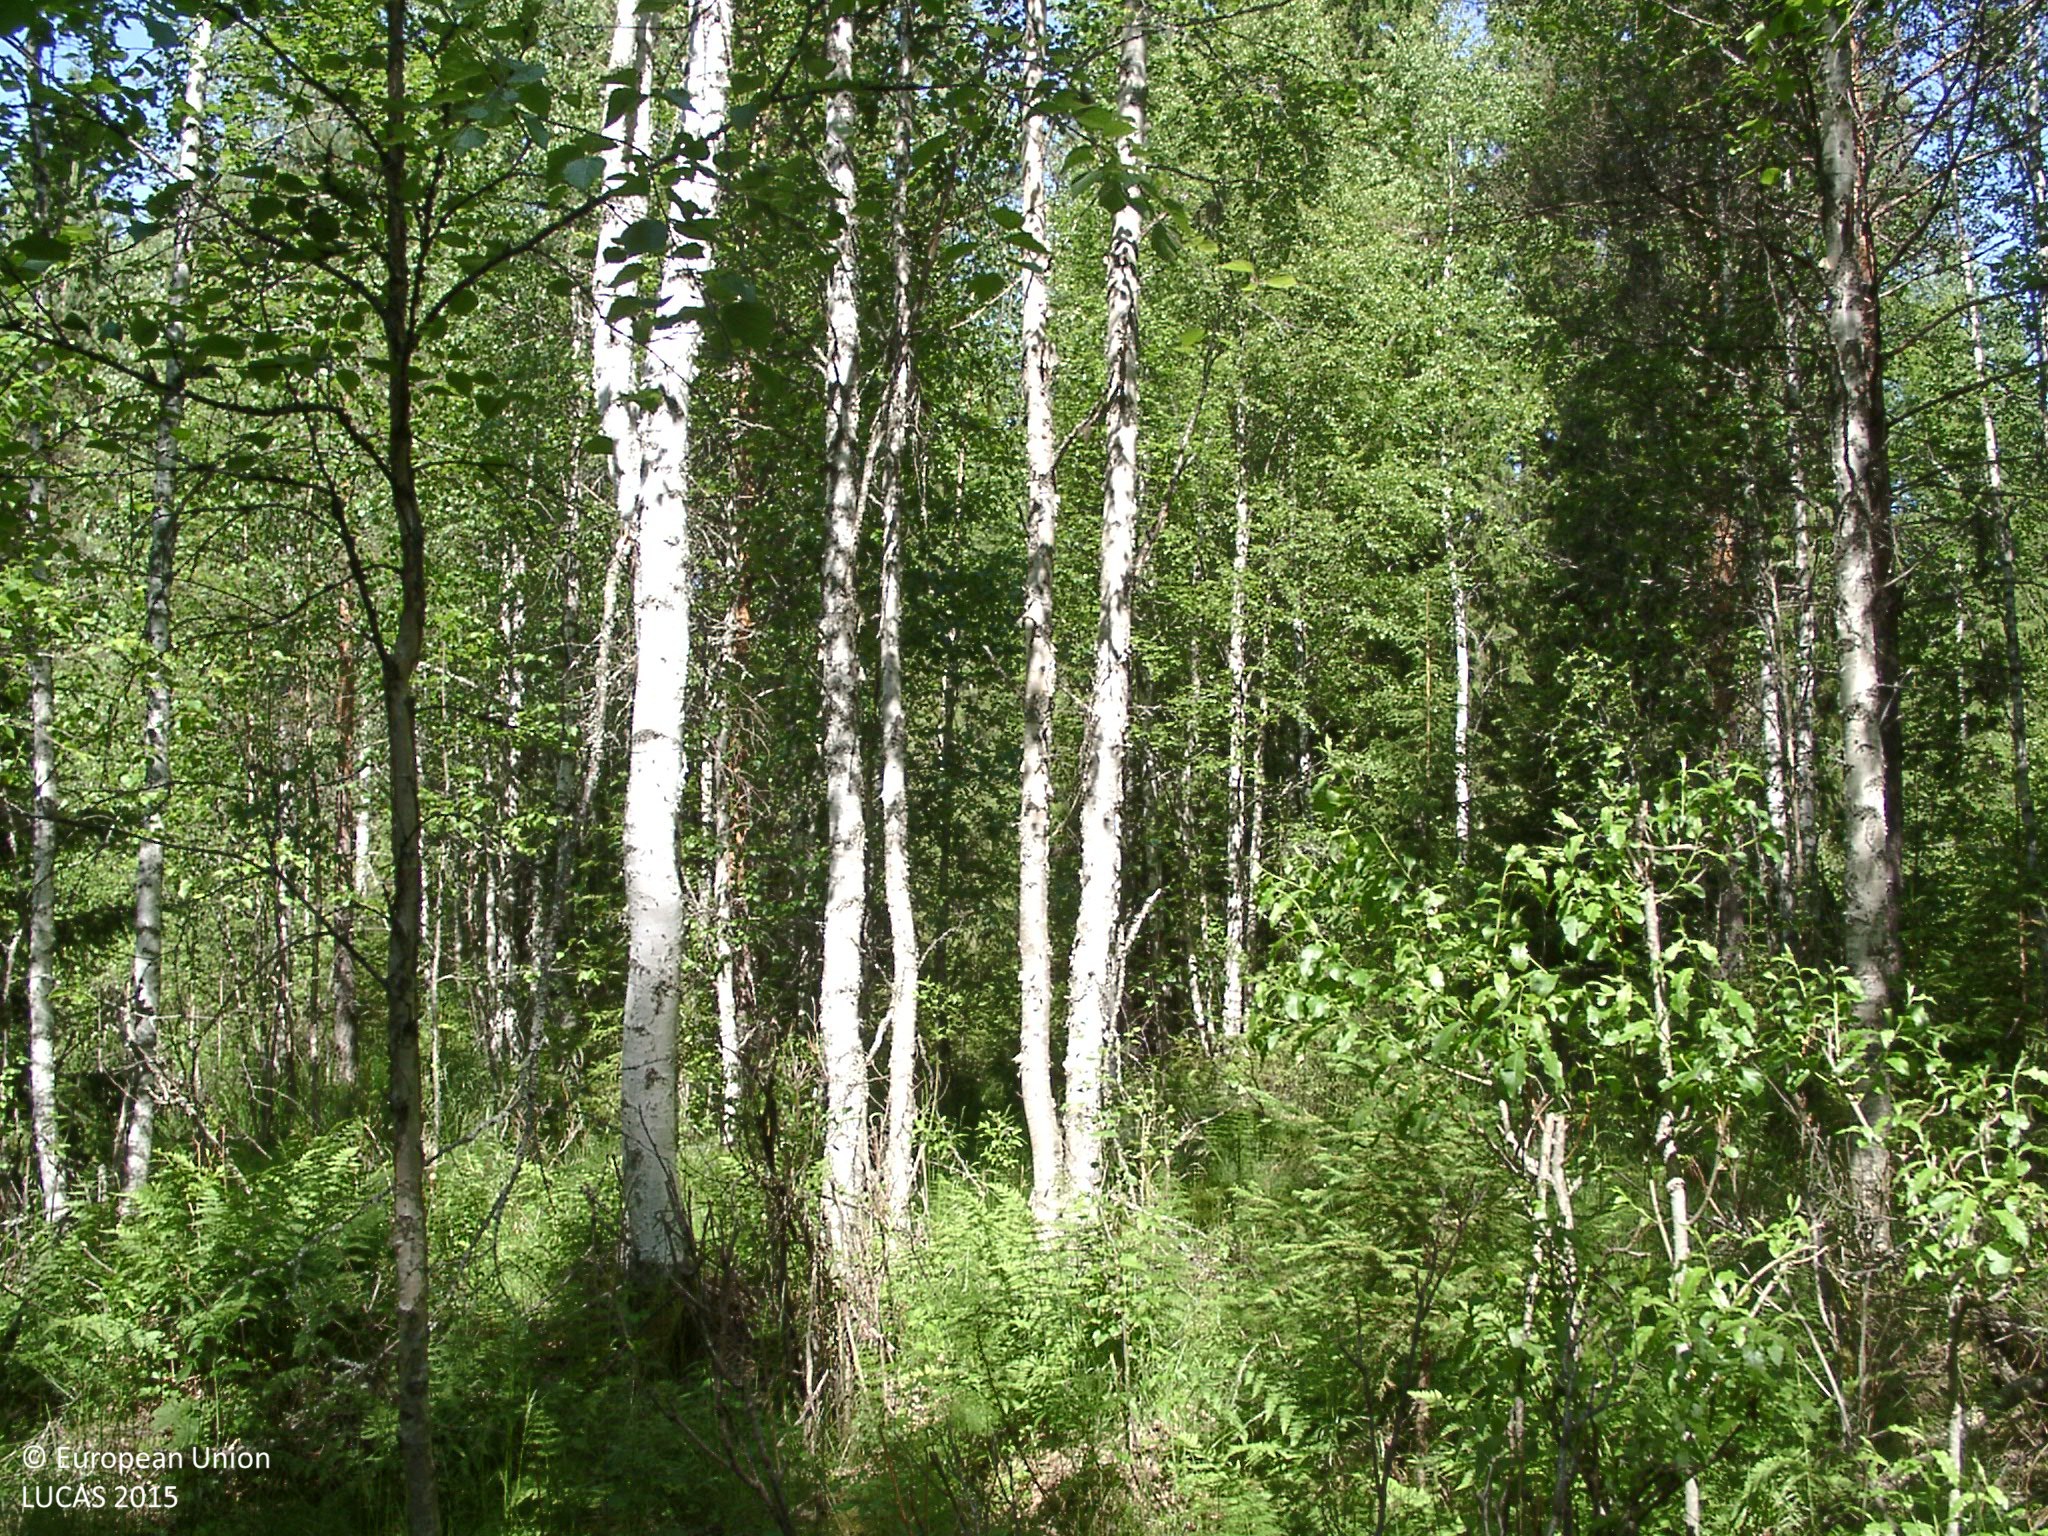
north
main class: Woodland
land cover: Spruce dominated mixed woodland
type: non-riverine alder, birch or aspen forest
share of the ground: 25 - 50 %
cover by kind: herbaceous plants 60 %, broadleaved forest trees 30 %, coniferous forest trees 10 %
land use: Forestry
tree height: > 5 m
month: July
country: FI
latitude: 62.0549
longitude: 25.2012
